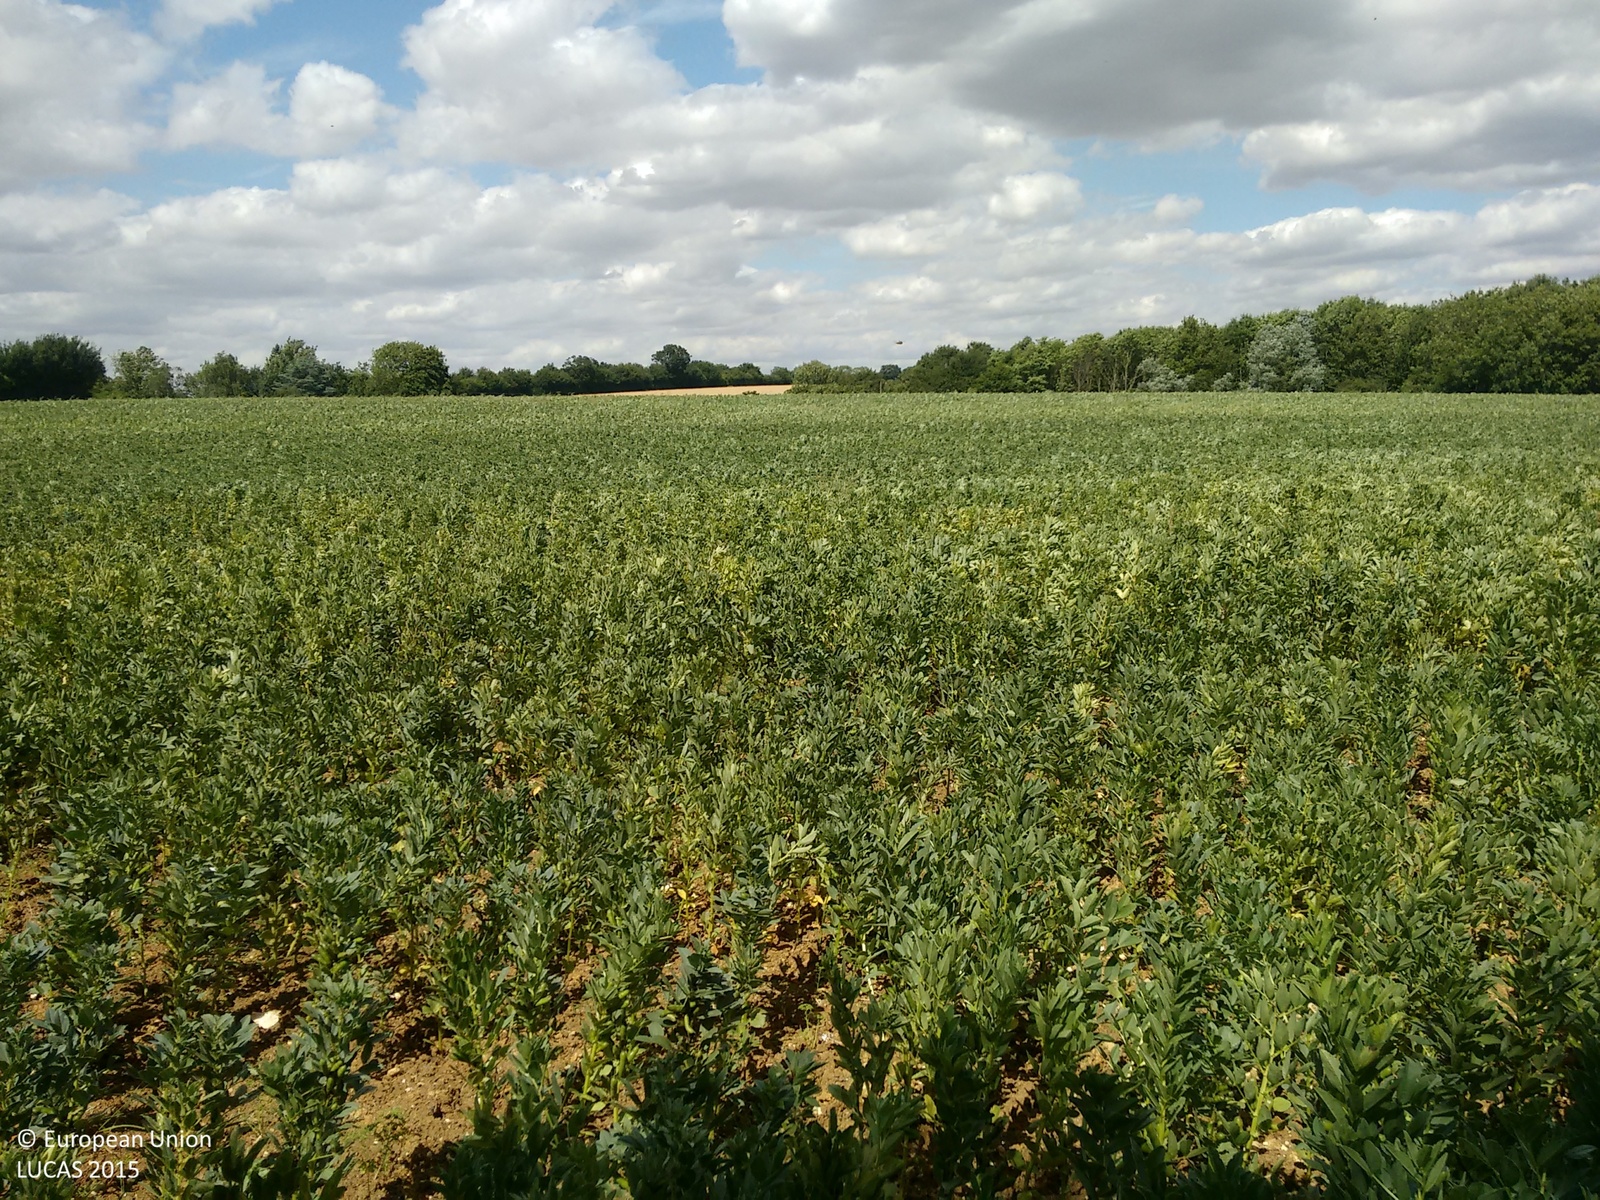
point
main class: Cropland
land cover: Dry pulses
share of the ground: > 75 %
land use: Agriculture (excluding fallow land and kitchen gardens)
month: July
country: GB
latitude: 51.8076
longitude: 0.4135
